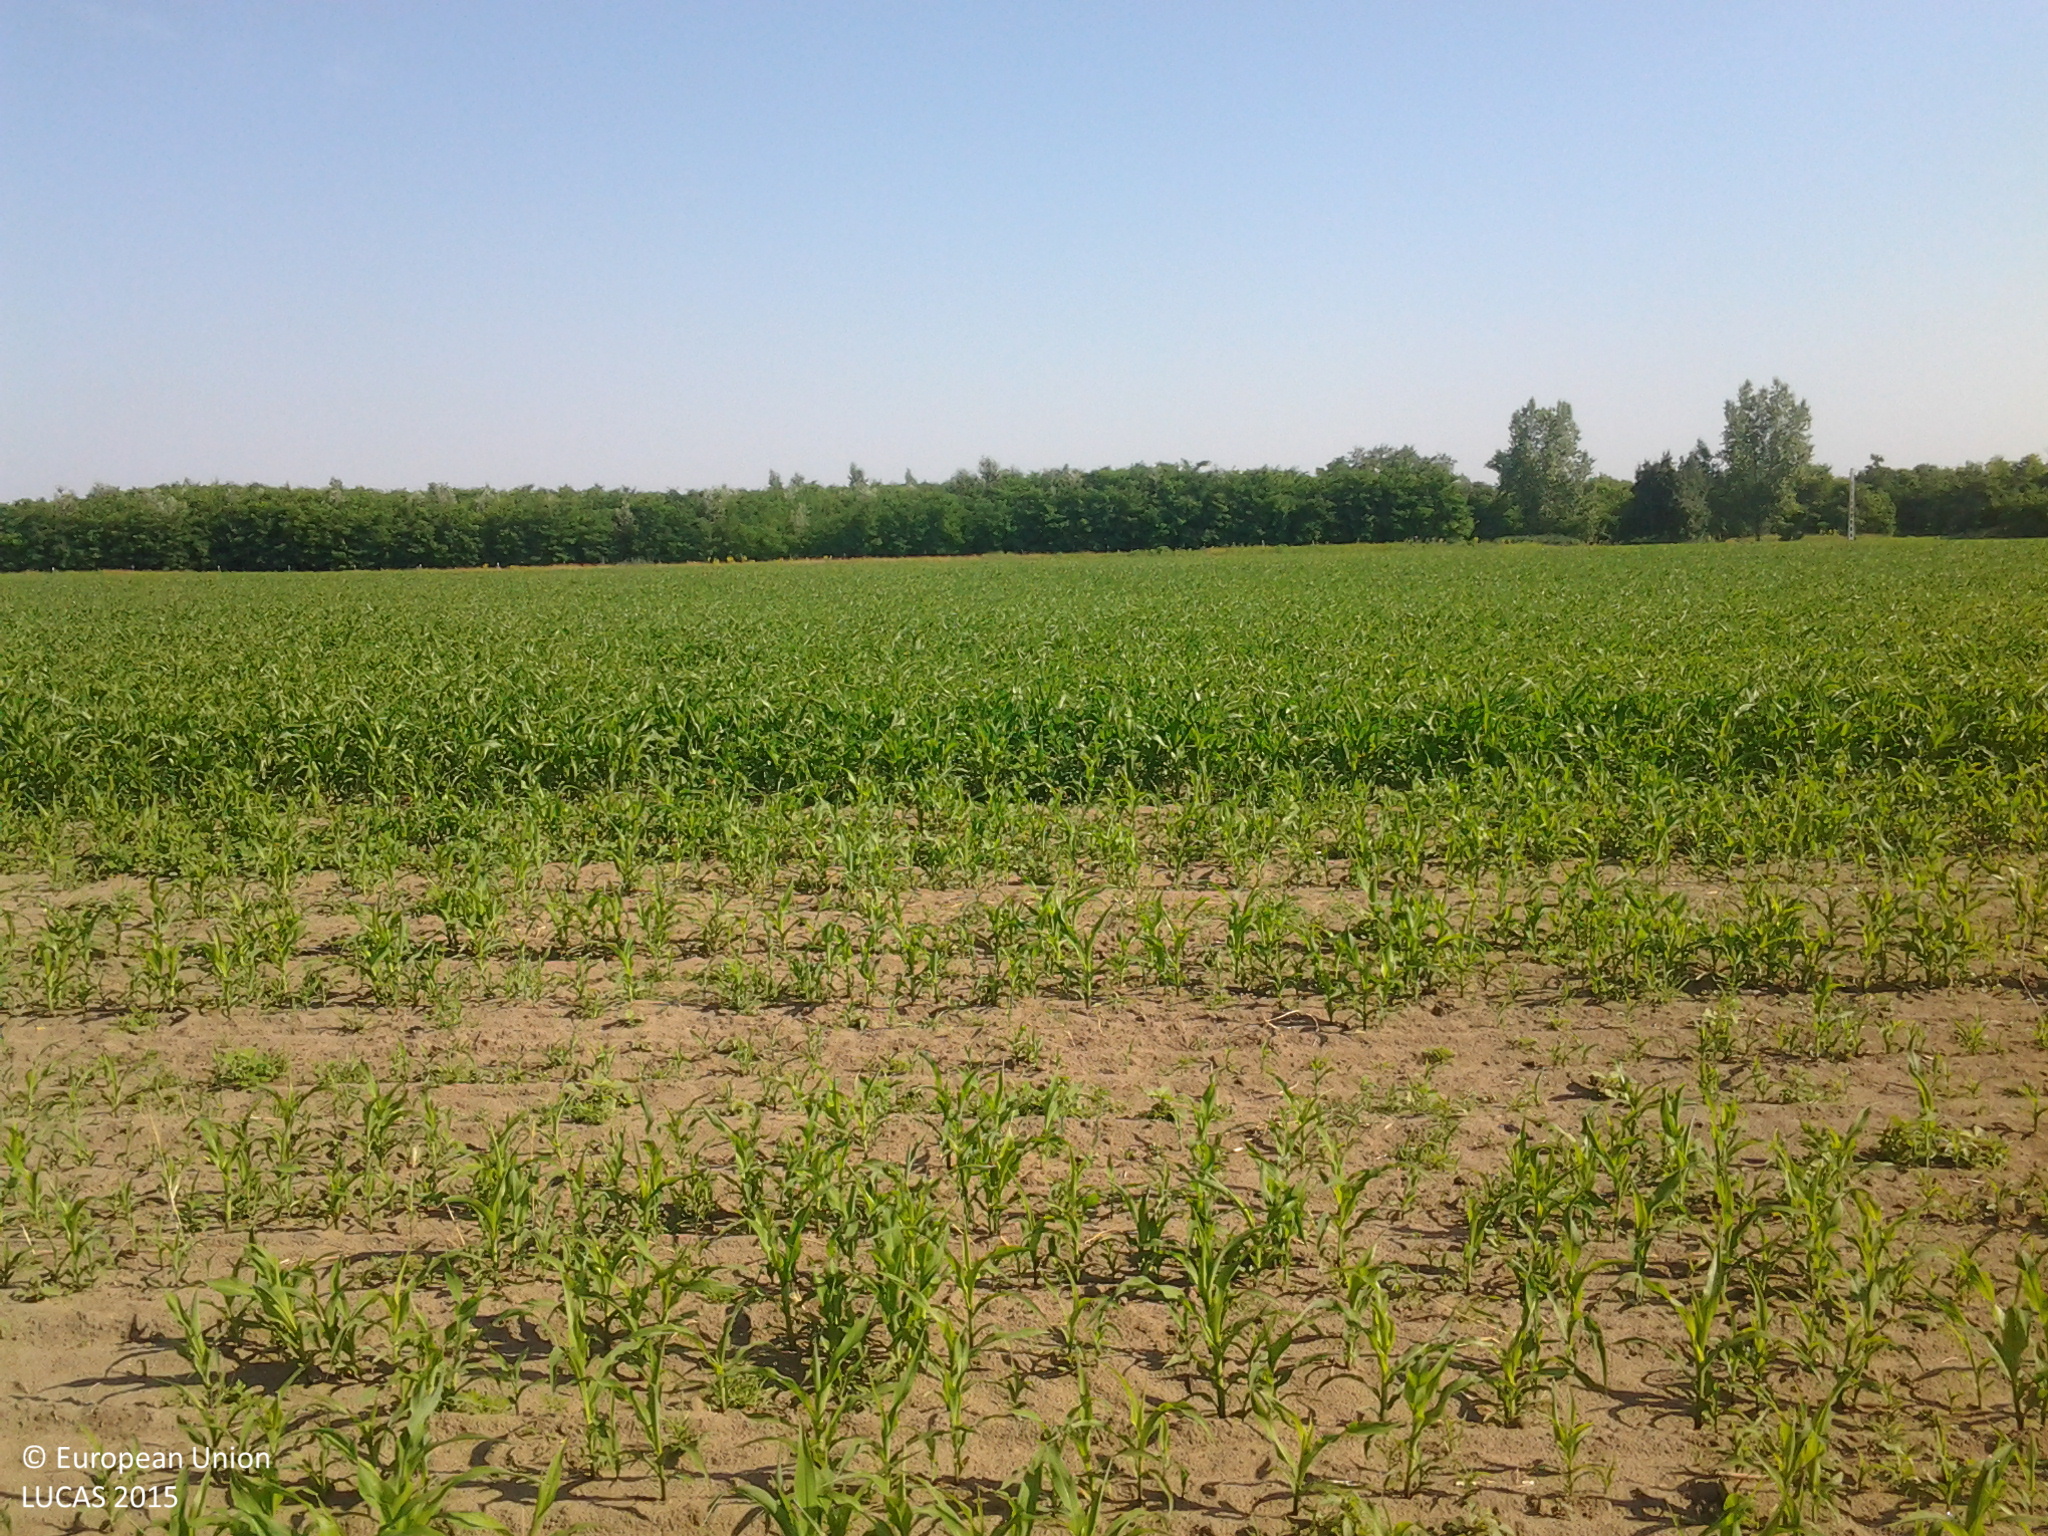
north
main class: Cropland
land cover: Maize
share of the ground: 50 - 75 %
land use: Agriculture (excluding fallow land and kitchen gardens)
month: July
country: HU
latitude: 46.6310
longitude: 19.5402
